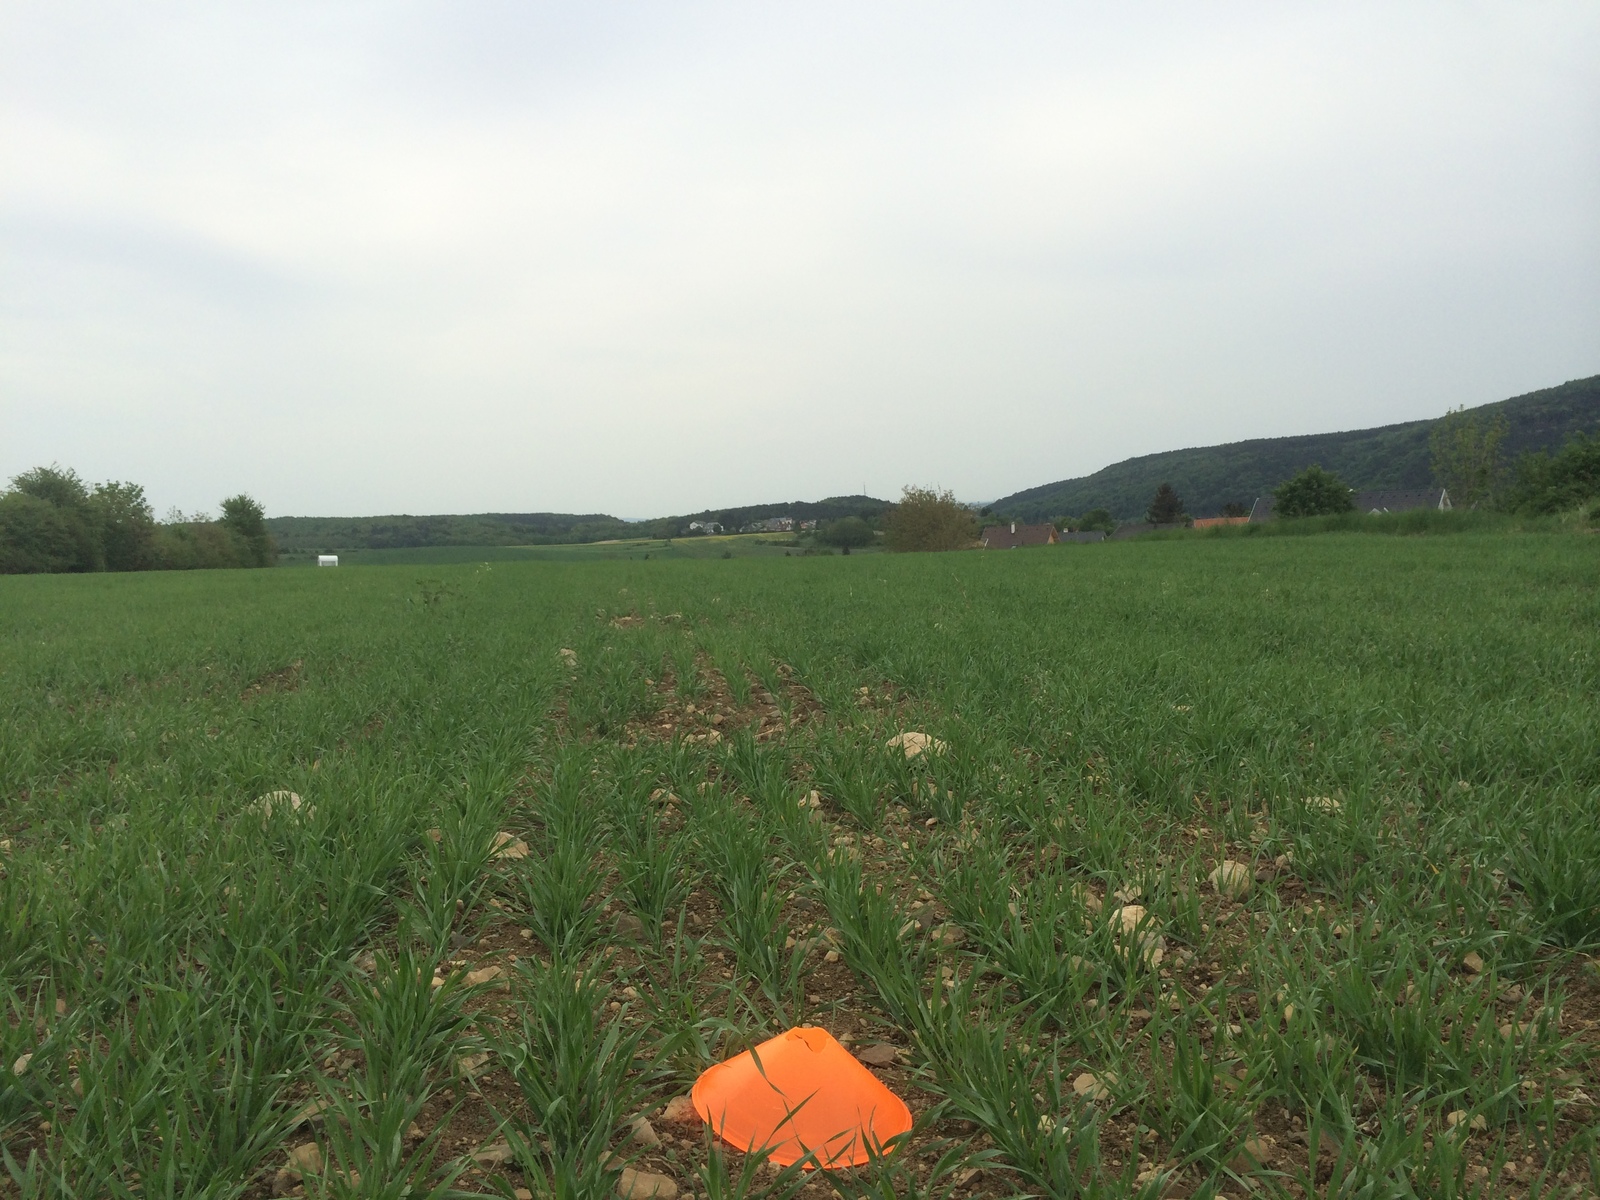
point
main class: Cropland
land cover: Barley
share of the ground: > 75 %
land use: Agriculture (excluding fallow land and kitchen gardens)
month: May
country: AT
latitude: 47.9436
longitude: 16.1488
